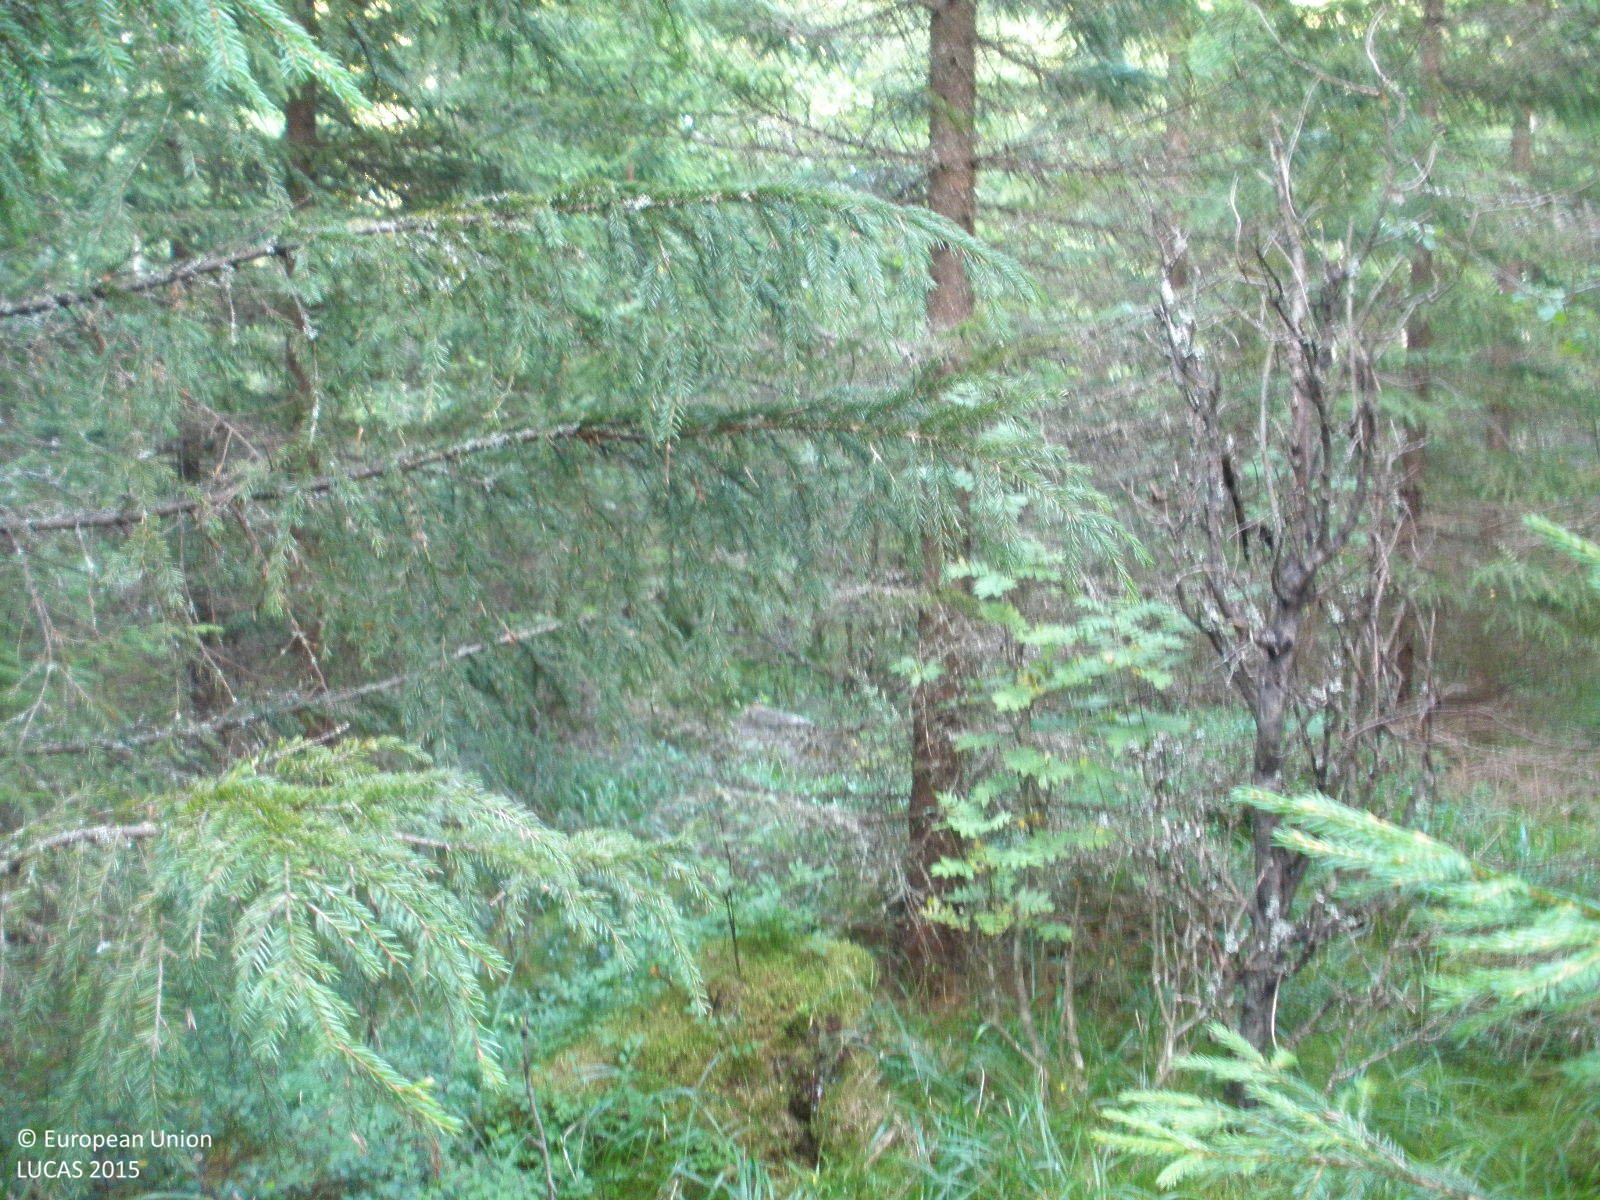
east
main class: Woodland
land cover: Spruce dominated coniferous woodland
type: boreal forest
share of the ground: > 75 %
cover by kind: coniferous forest trees 80 %, lichens and mosses 10 %, broadleaved forest trees 5 %, herbaceous plants 5 %
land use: Forestry
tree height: > 5 m
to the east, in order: Spruce dominated coniferous woodland; Spruce dominated mixed woodland; Spruce dominated coniferous woodland; Ditches and canals; Spruce dominated coniferous woodland; Ditches and canals; Spruce dominated coniferous woodland; Tracks; Spruce dominated mixed woodland
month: August
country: FI
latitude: 61.0090
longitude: 24.8137
